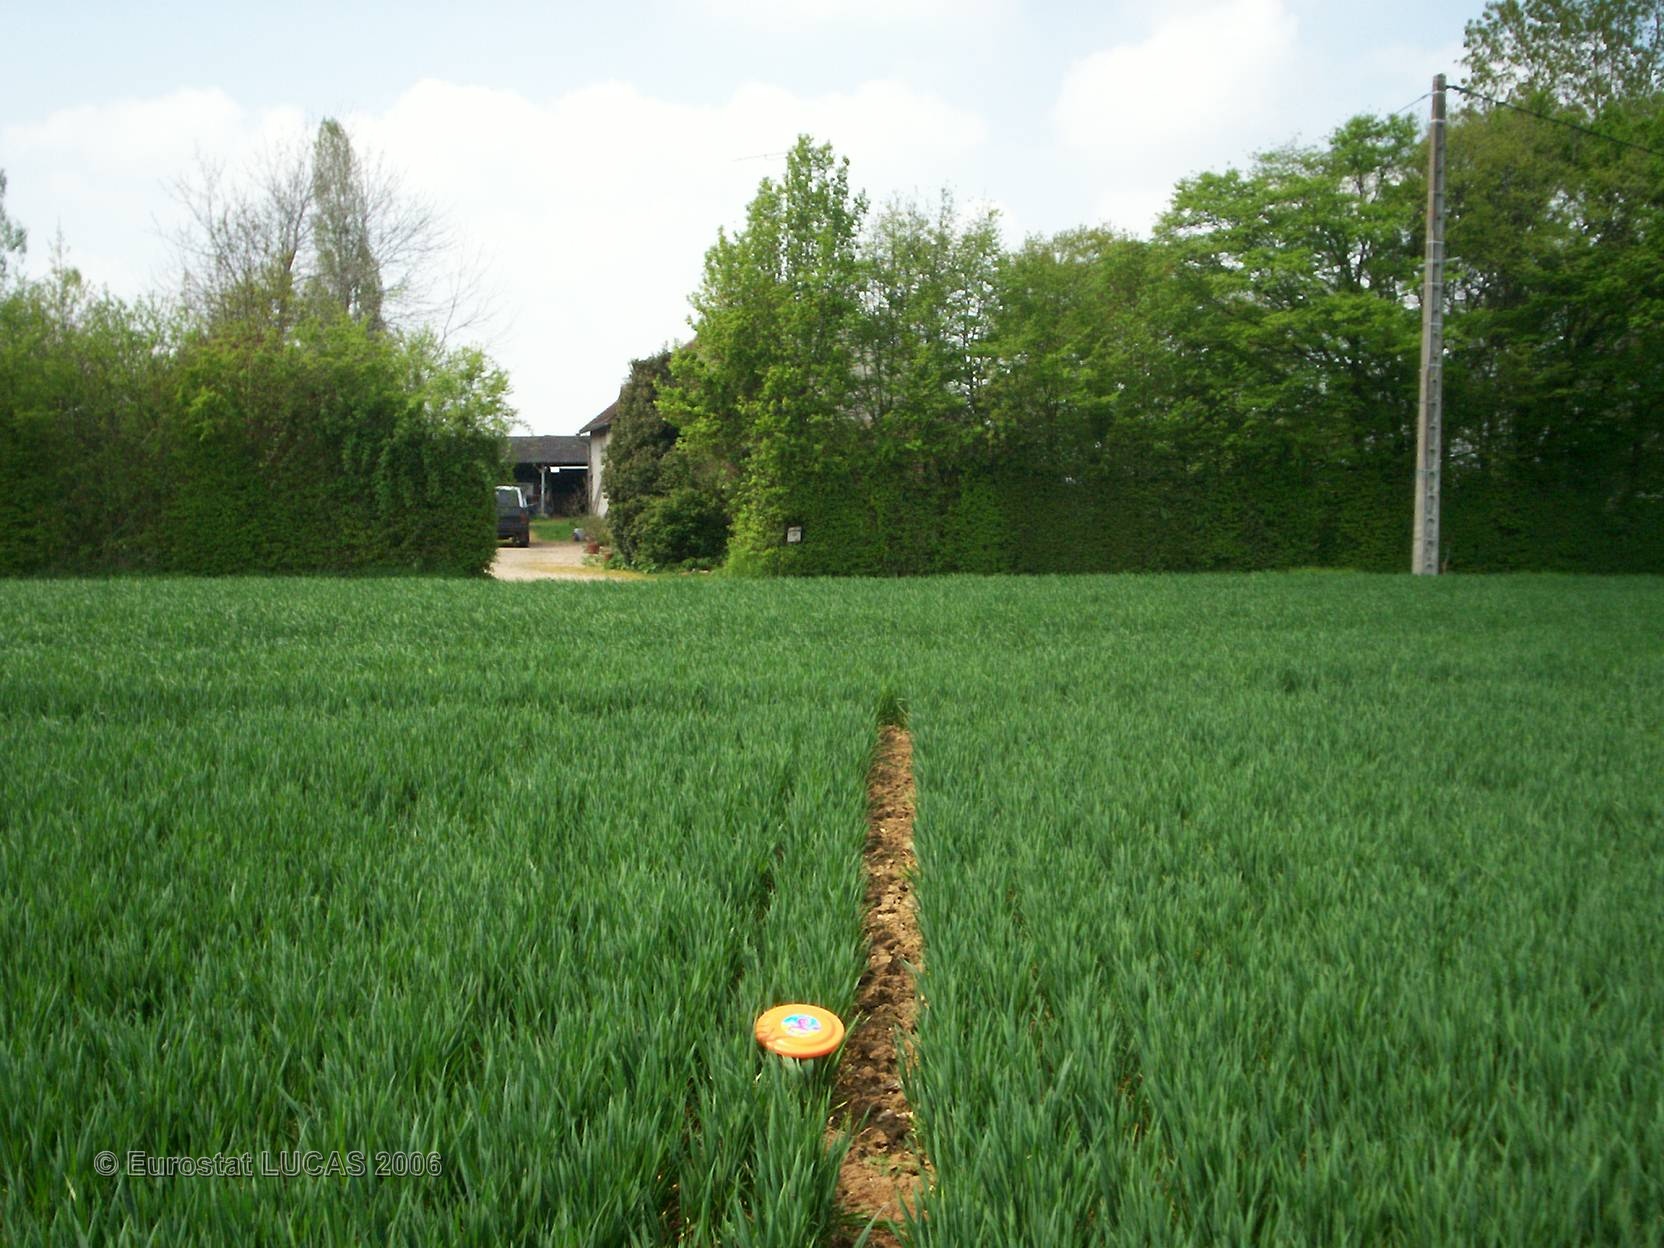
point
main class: Cropland
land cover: Common wheat
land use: Agriculture (excluding fallow land and kitchen gardens)
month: April
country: FR
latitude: 47.9214
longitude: 2.8866
